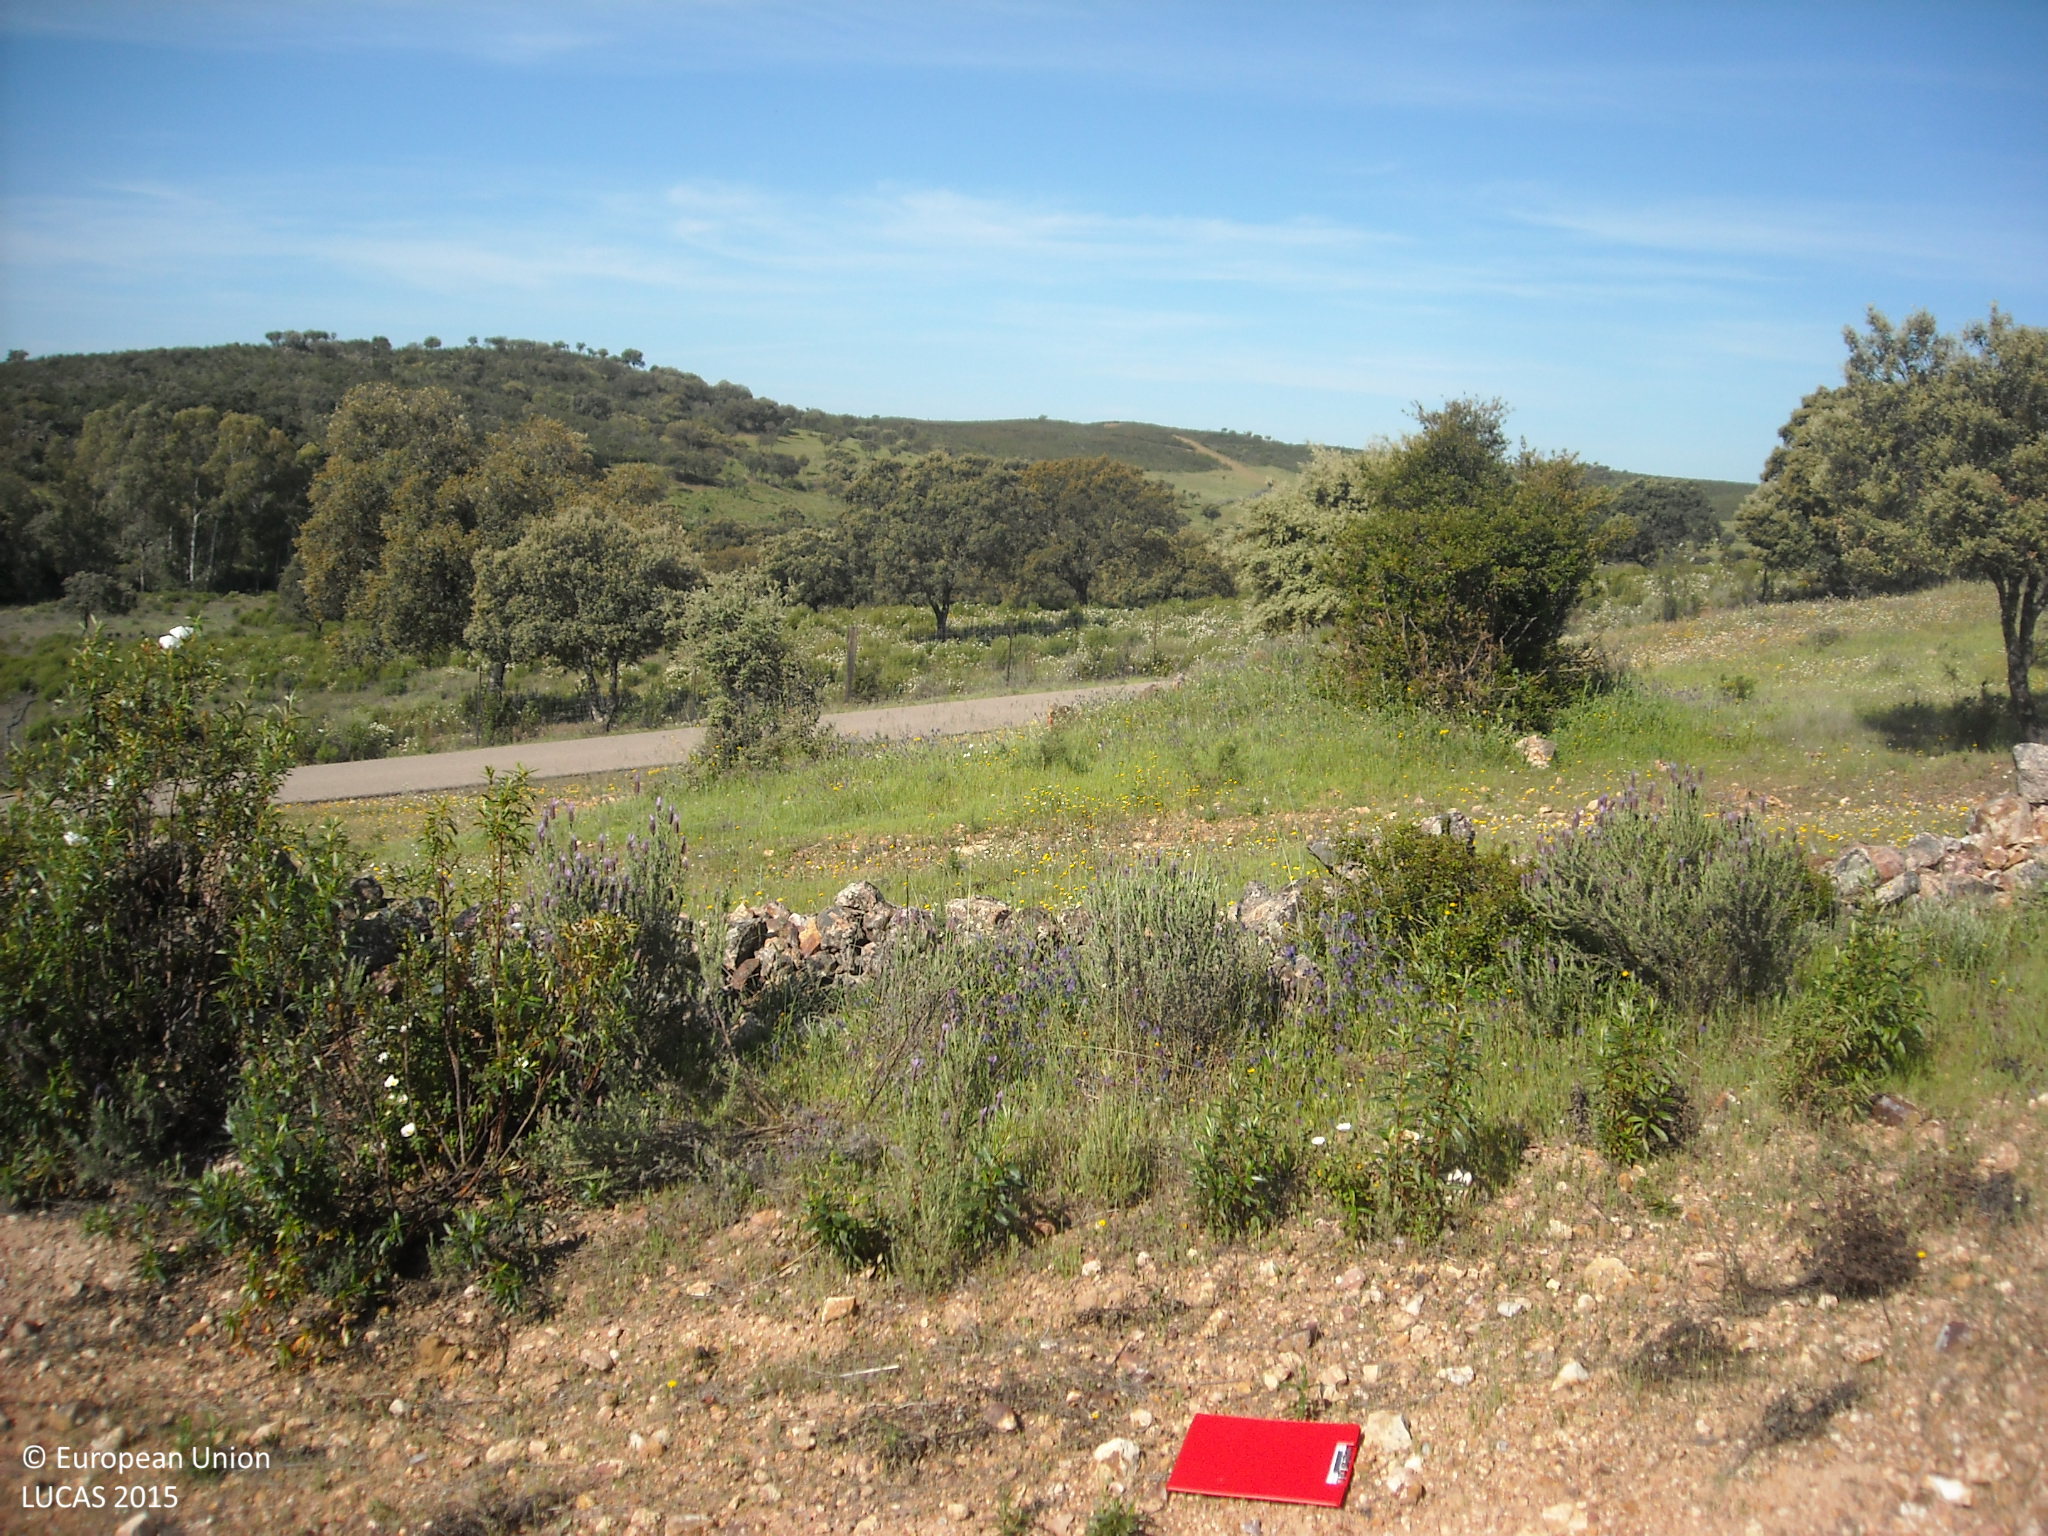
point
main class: Woodland
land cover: Broadleaved woodland
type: broadleaved evergreen forest
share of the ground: 10 - 25 %
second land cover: Grassland without tree/shrub cover
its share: > 75 %
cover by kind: herbaceous plants 70 %, unconsolidated bare surface 20 %, broadleaved forest trees 10 %
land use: Forestry
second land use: Agriculture (excluding fallow land and kitchen gardens)
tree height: > 5 m
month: April
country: ES
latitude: 37.7655
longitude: -6.0030
